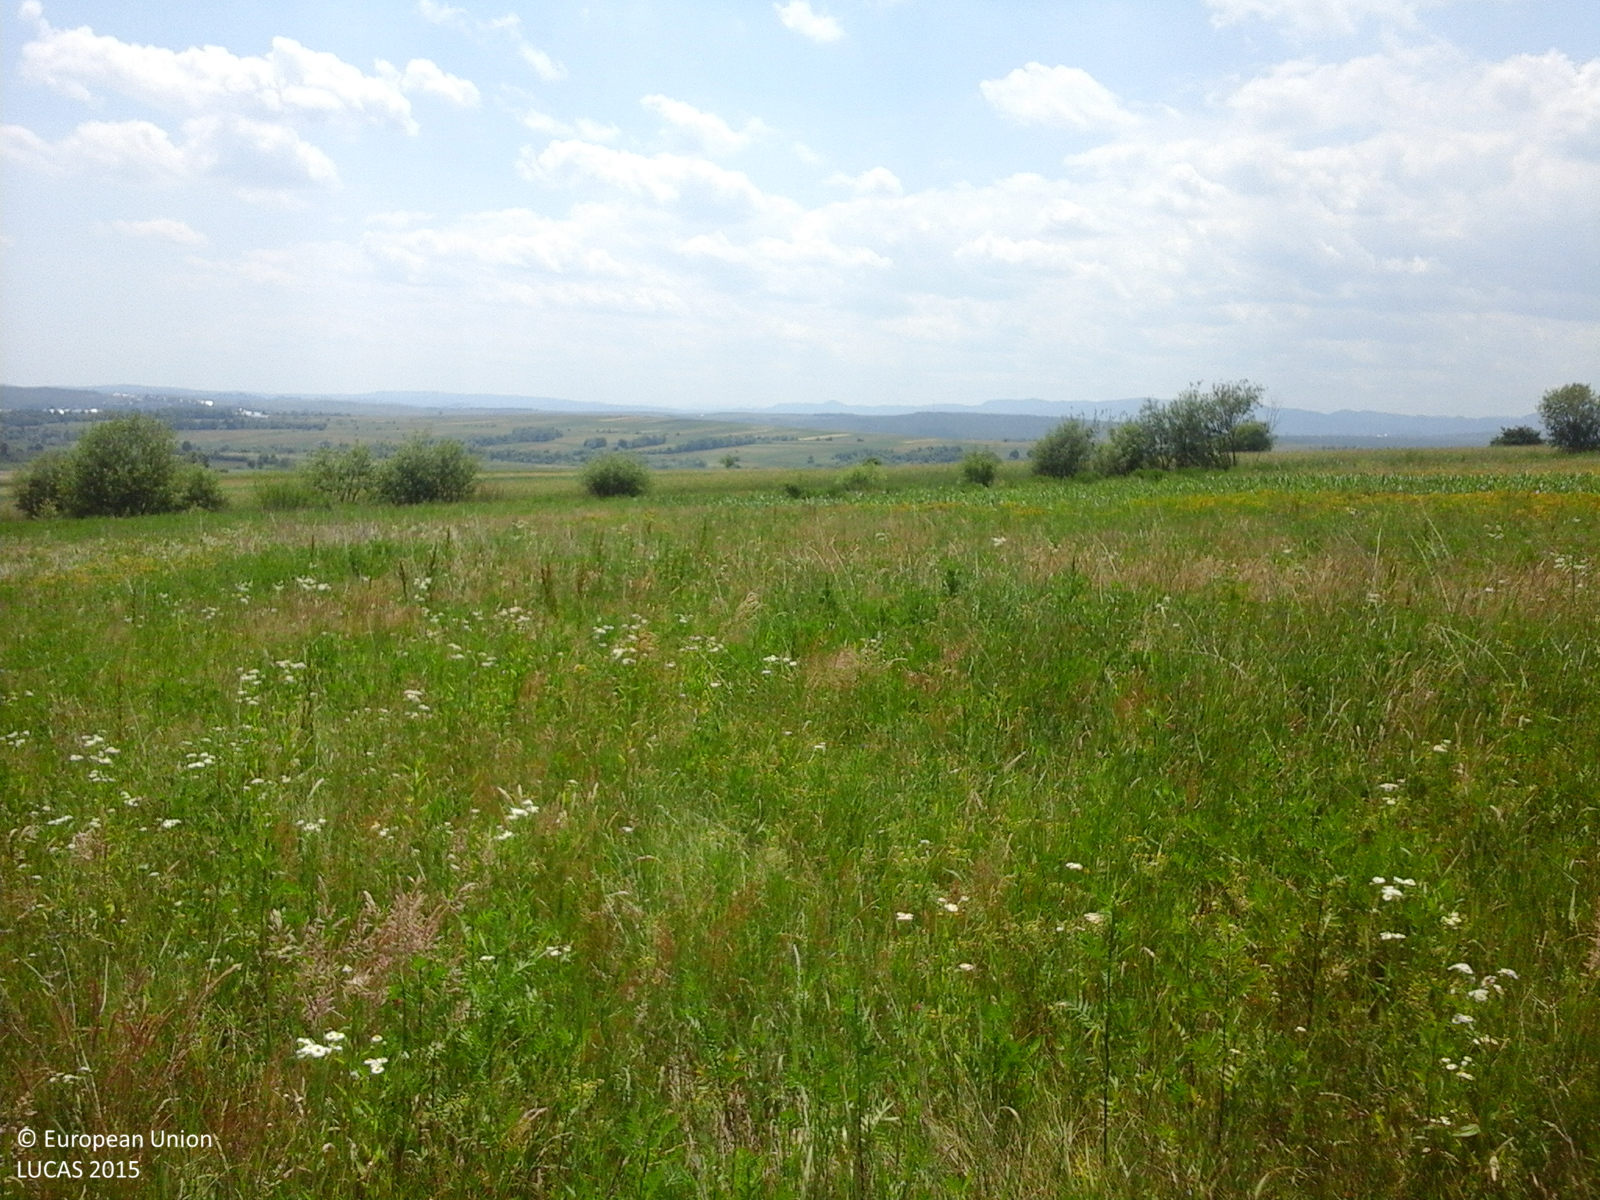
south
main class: Grassland
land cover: Grassland without tree/shrub cover
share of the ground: > 75 %
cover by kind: herbaceous plants 100 %
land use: Agriculture (excluding fallow land and kitchen gardens)
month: June
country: RO
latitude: 47.7592
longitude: 25.8829
